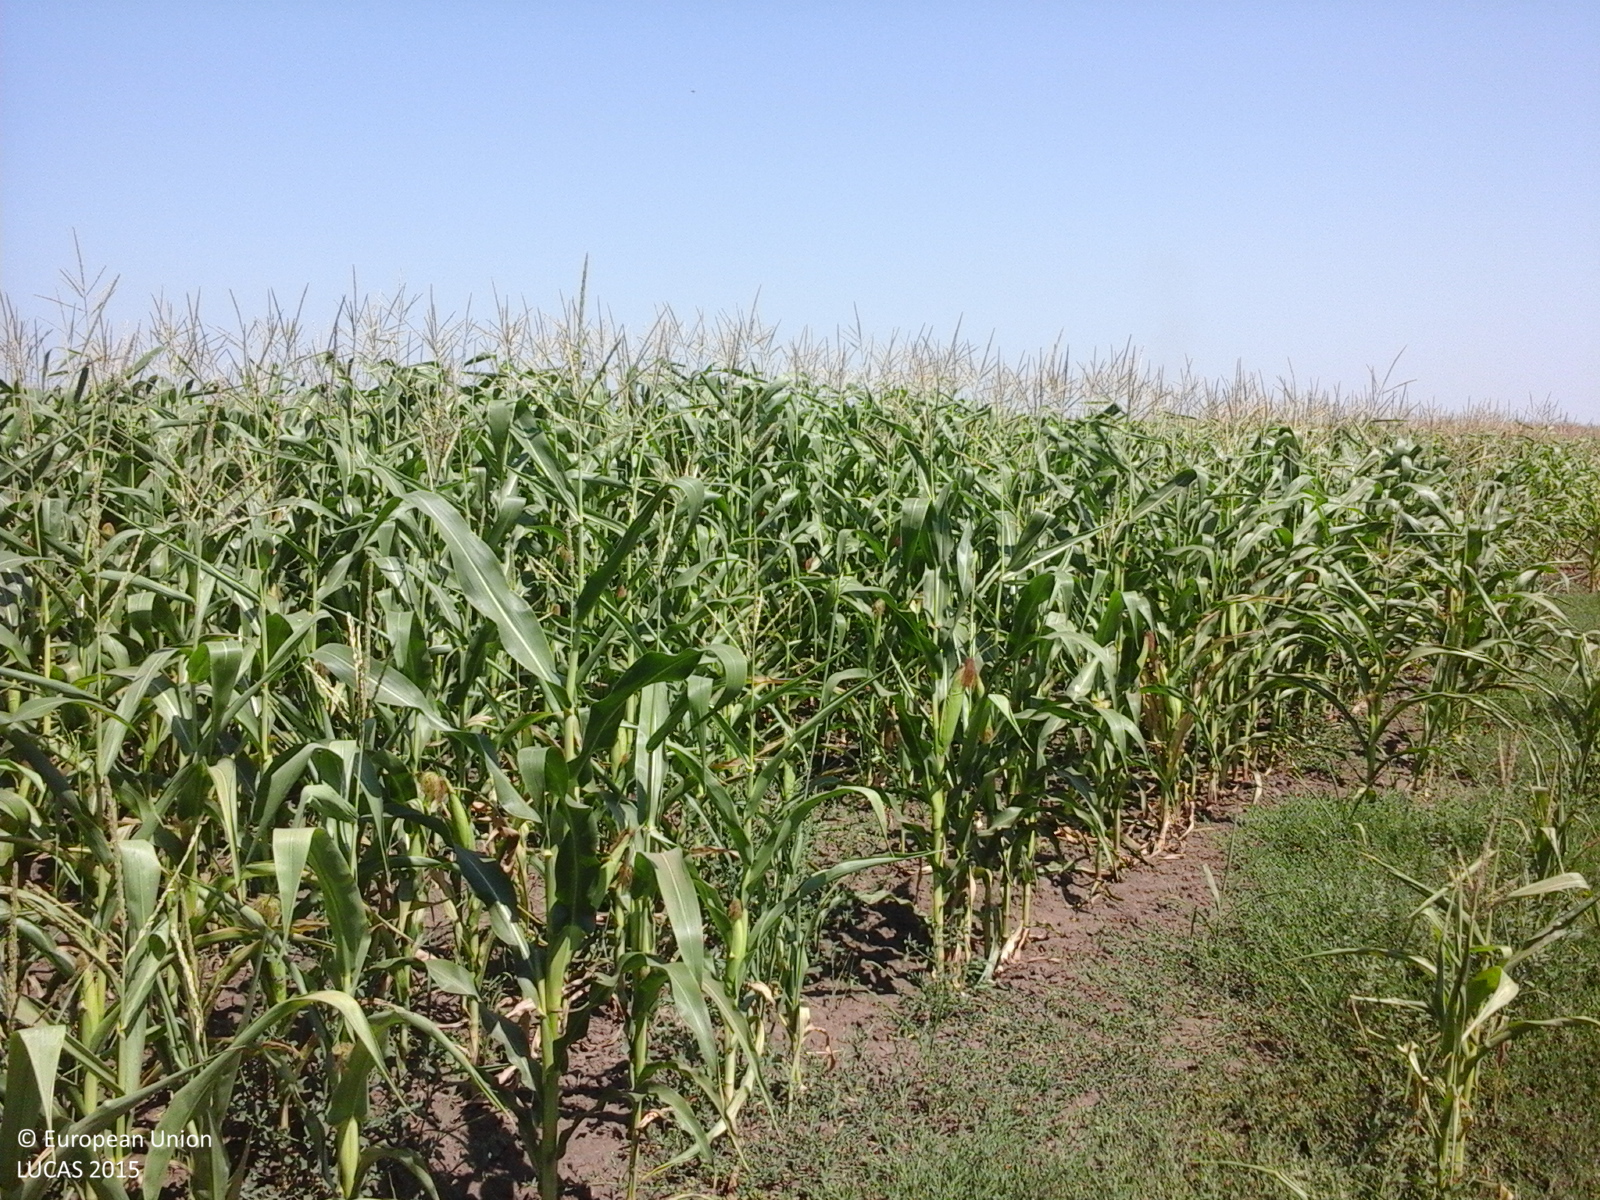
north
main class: Cropland
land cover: Maize
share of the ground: > 75 %
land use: Agriculture (excluding fallow land and kitchen gardens)
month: July
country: RO
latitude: 44.3315
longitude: 27.1233
